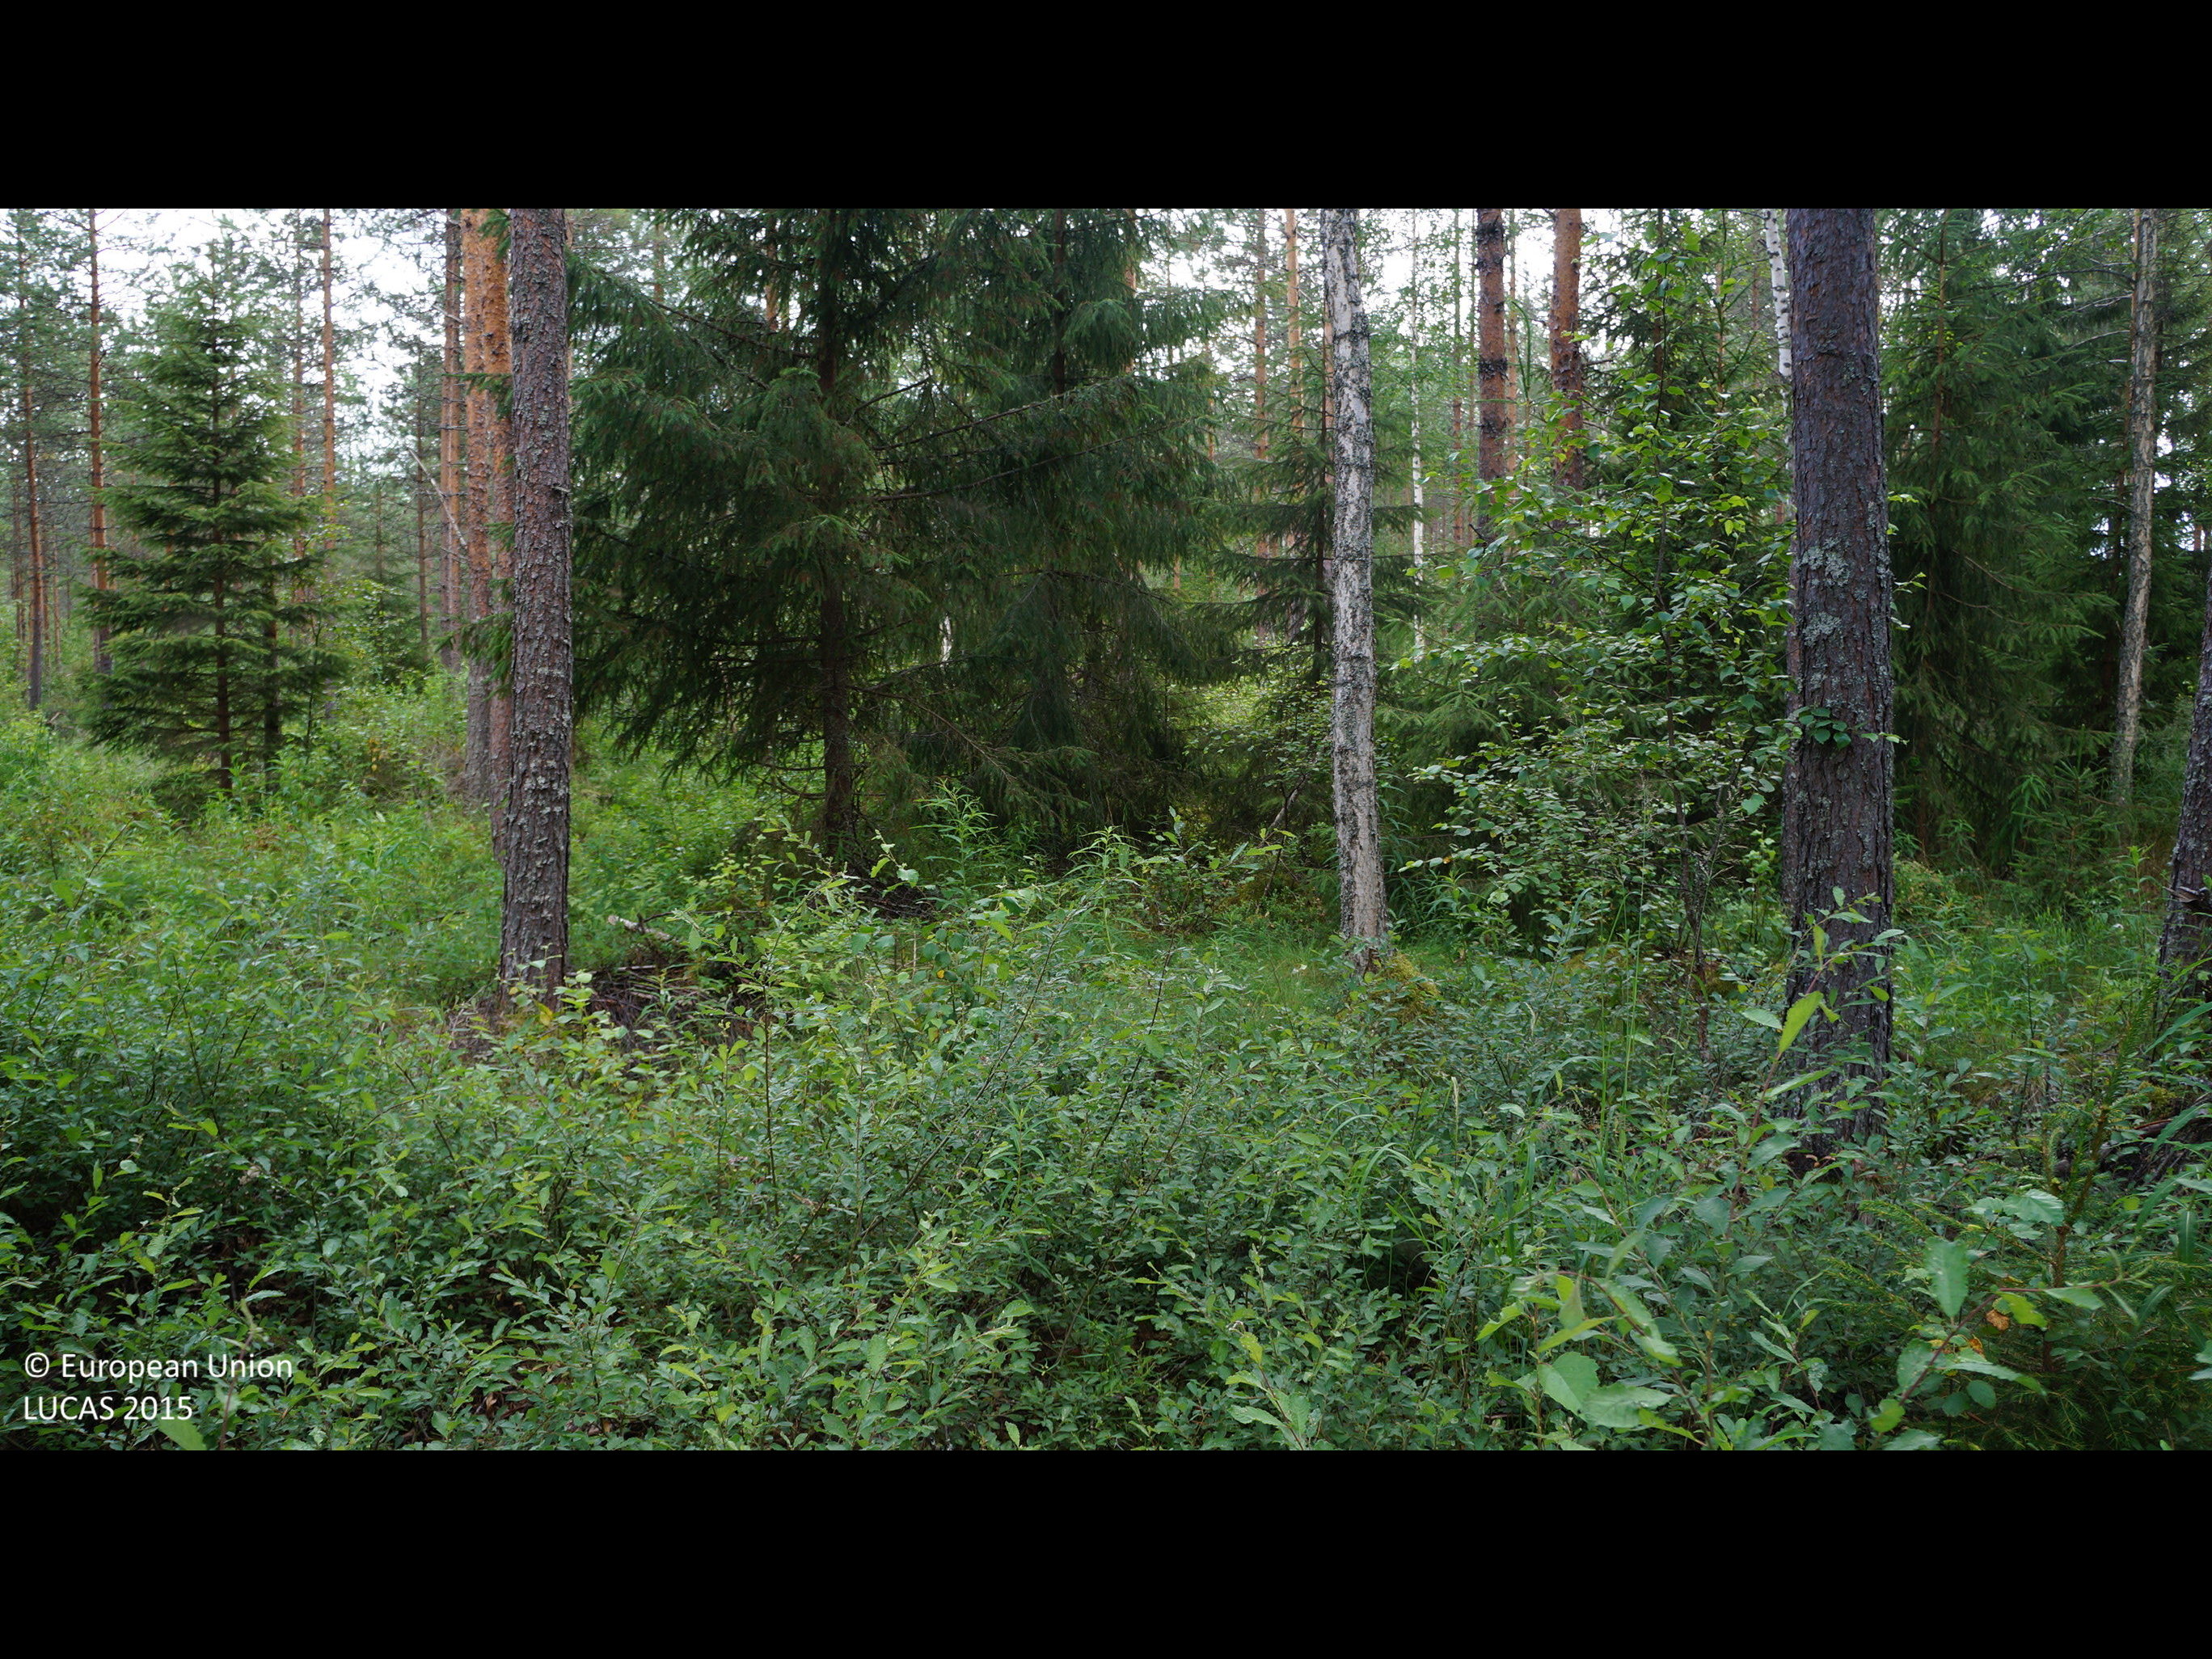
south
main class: Woodland
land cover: Pine dominated mixed woodland
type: boreal forest
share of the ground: 50 - 75 %
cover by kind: coniferous forest trees 30 %, herbaceous plants 30 %, broadleaved forest trees 20 %, shrubs 20 %
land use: Forestry
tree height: > 5 m
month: July
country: FI
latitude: 64.0157
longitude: 24.3717
